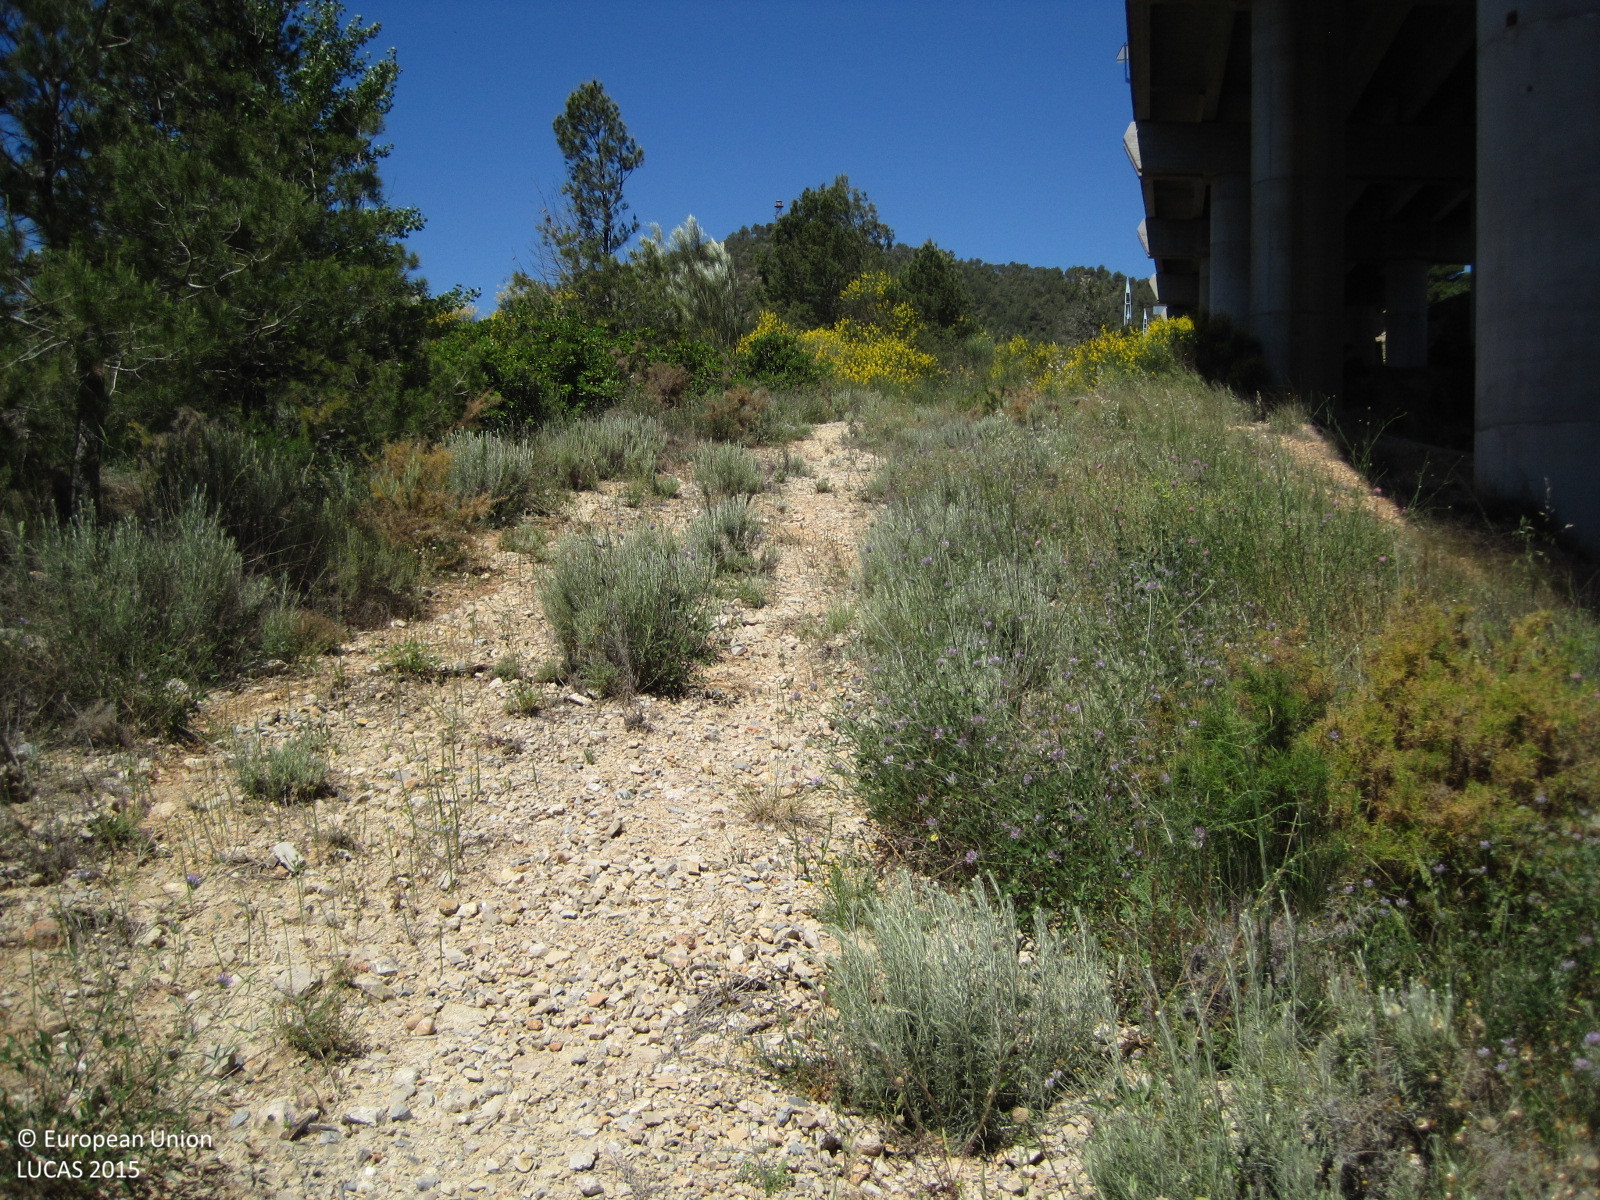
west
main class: Artificial land
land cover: Non built-up linear features
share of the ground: > 75 %
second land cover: Grassland without tree/shrub cover
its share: > 75 %
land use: Road transport
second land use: Forestry
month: May
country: ES
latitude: 39.4305
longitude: -0.8148
